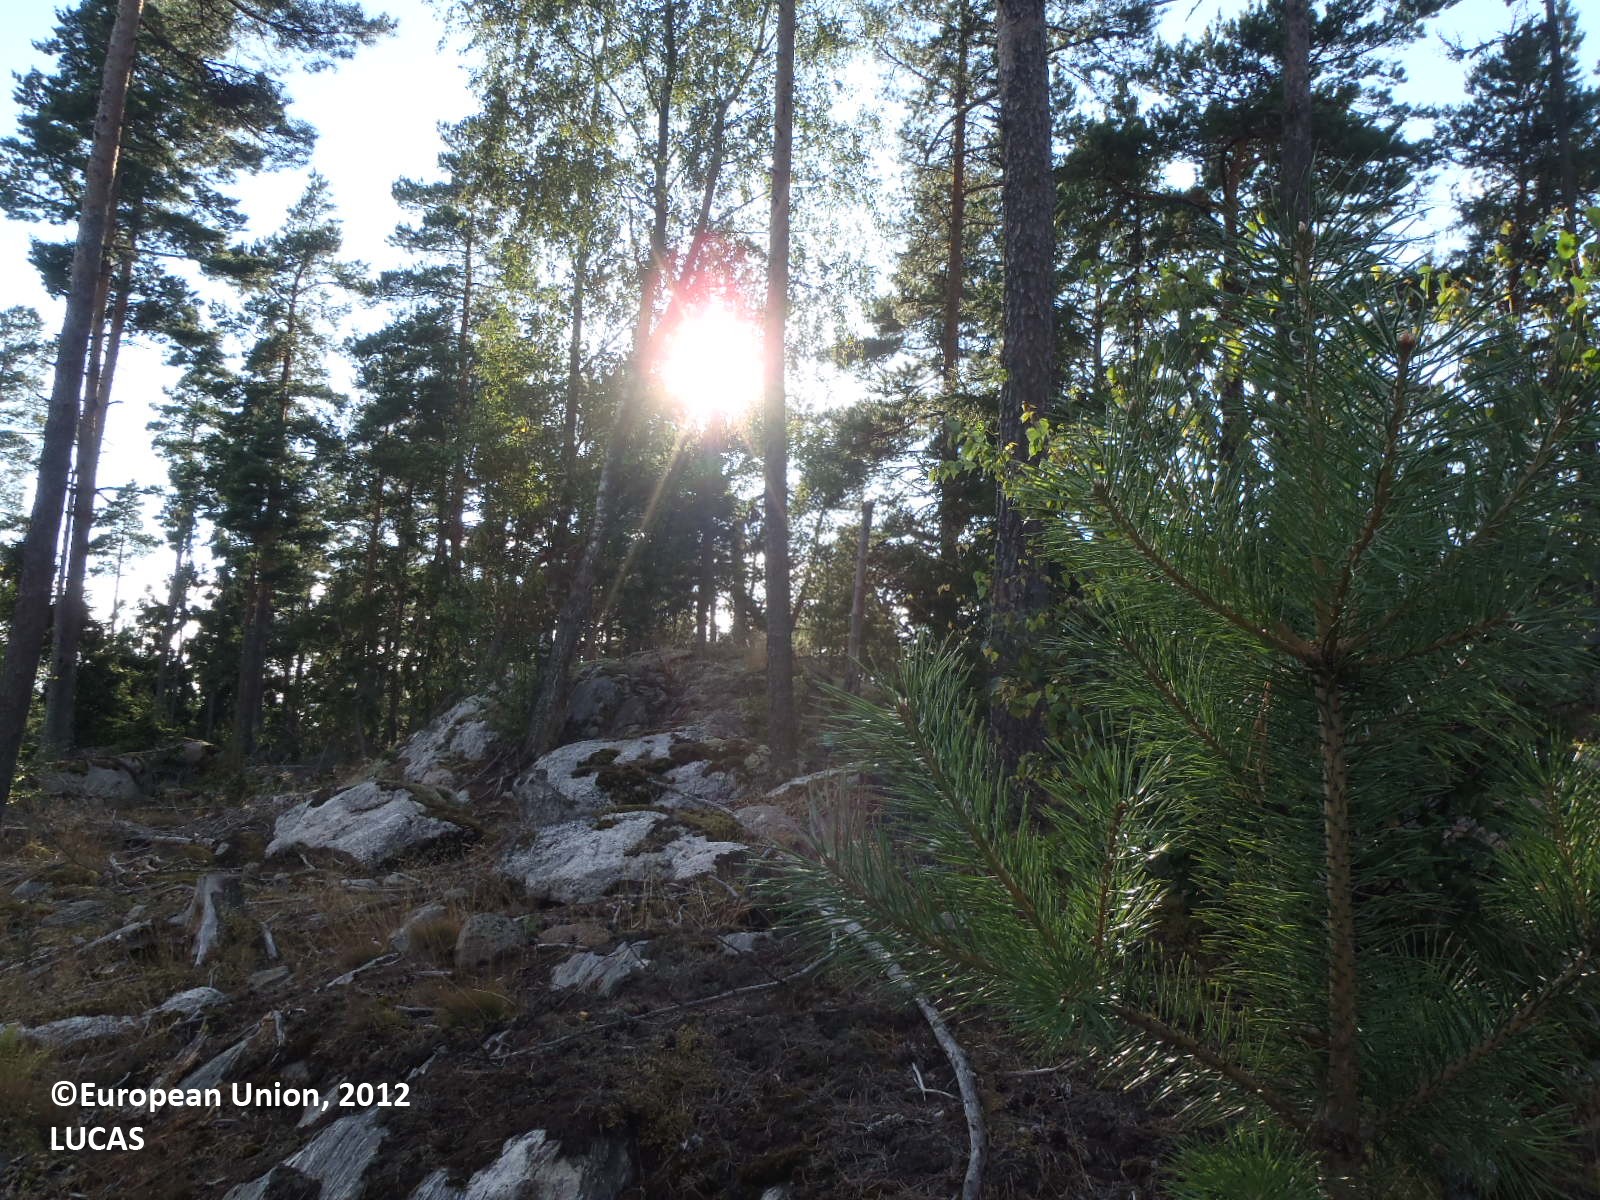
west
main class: Woodland
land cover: Pine dominated mixed woodland
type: boreal forest
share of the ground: 10 - 25 %
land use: Forestry
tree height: > 5 m
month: August
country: FI
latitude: 60.1257
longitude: 21.5242
